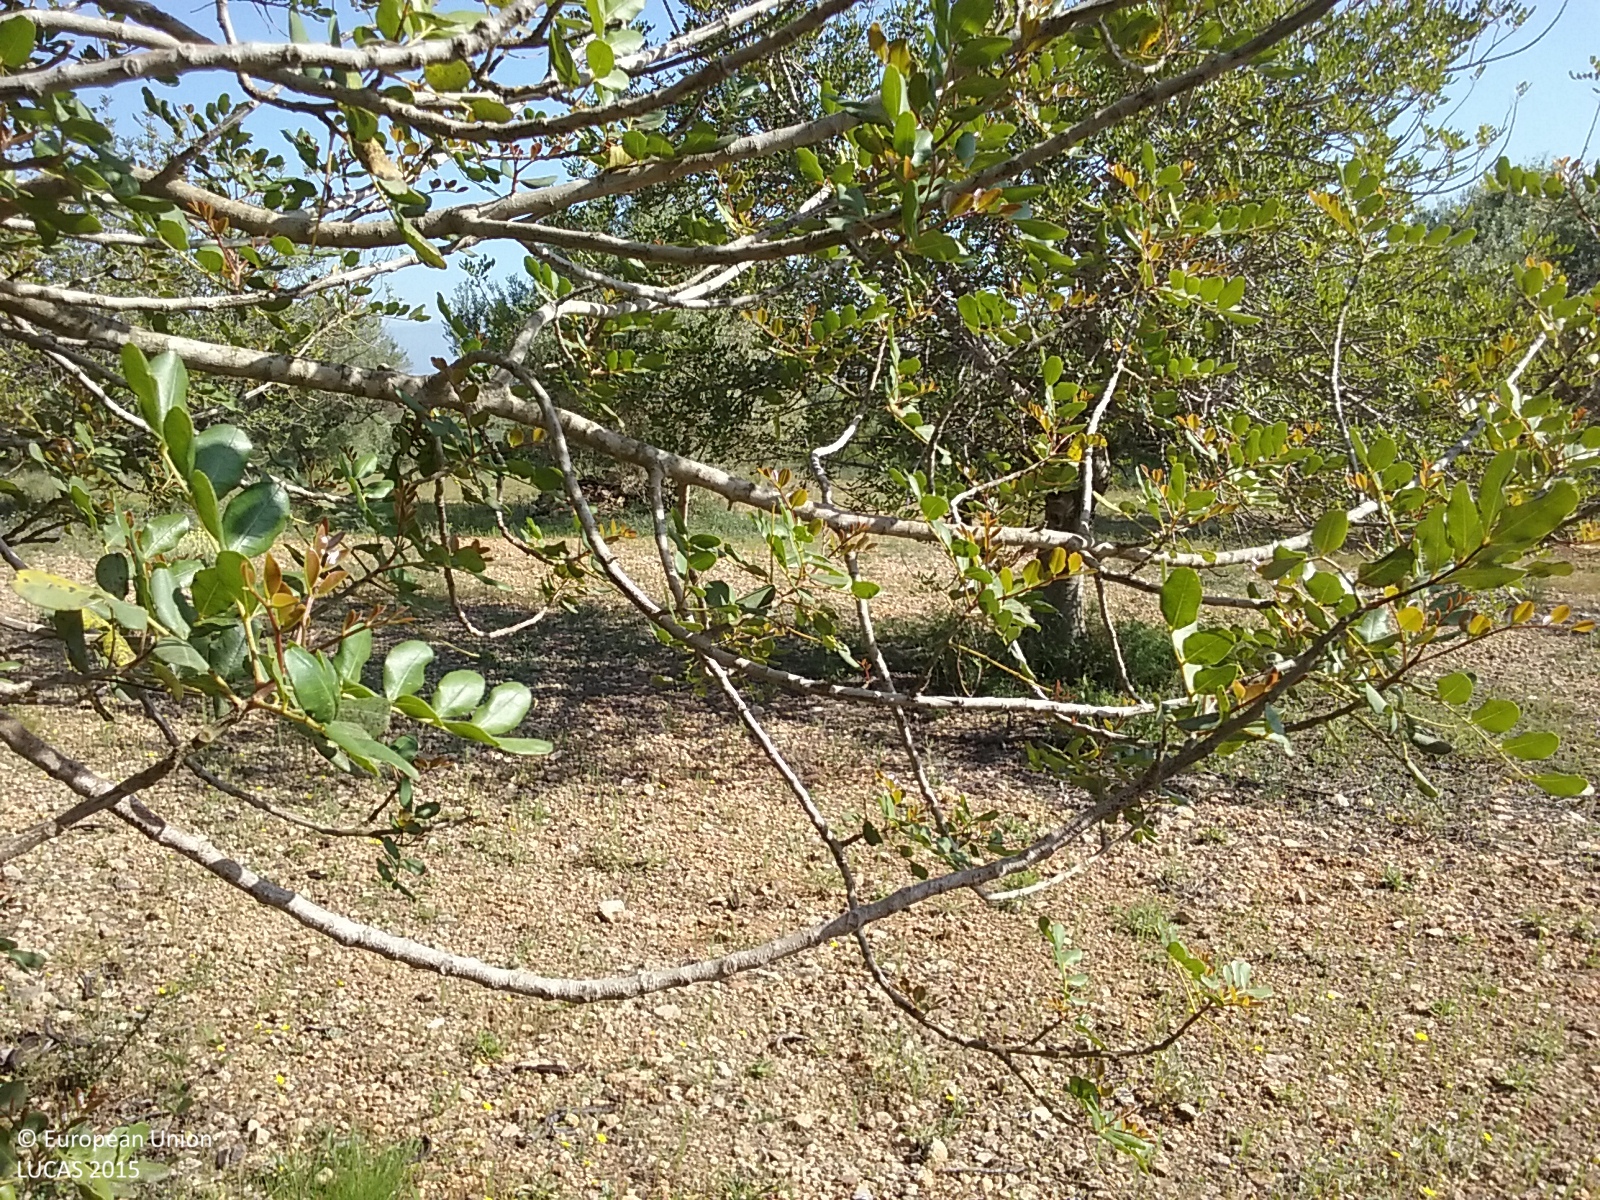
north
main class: Cropland
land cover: Permanent industrial crops
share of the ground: 25 - 50 %
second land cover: Spontaneously vegetated surfaces
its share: 25 - 50 %
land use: Agriculture (excluding fallow land and kitchen gardens)
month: May
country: ES
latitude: 40.5347
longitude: 0.3265
